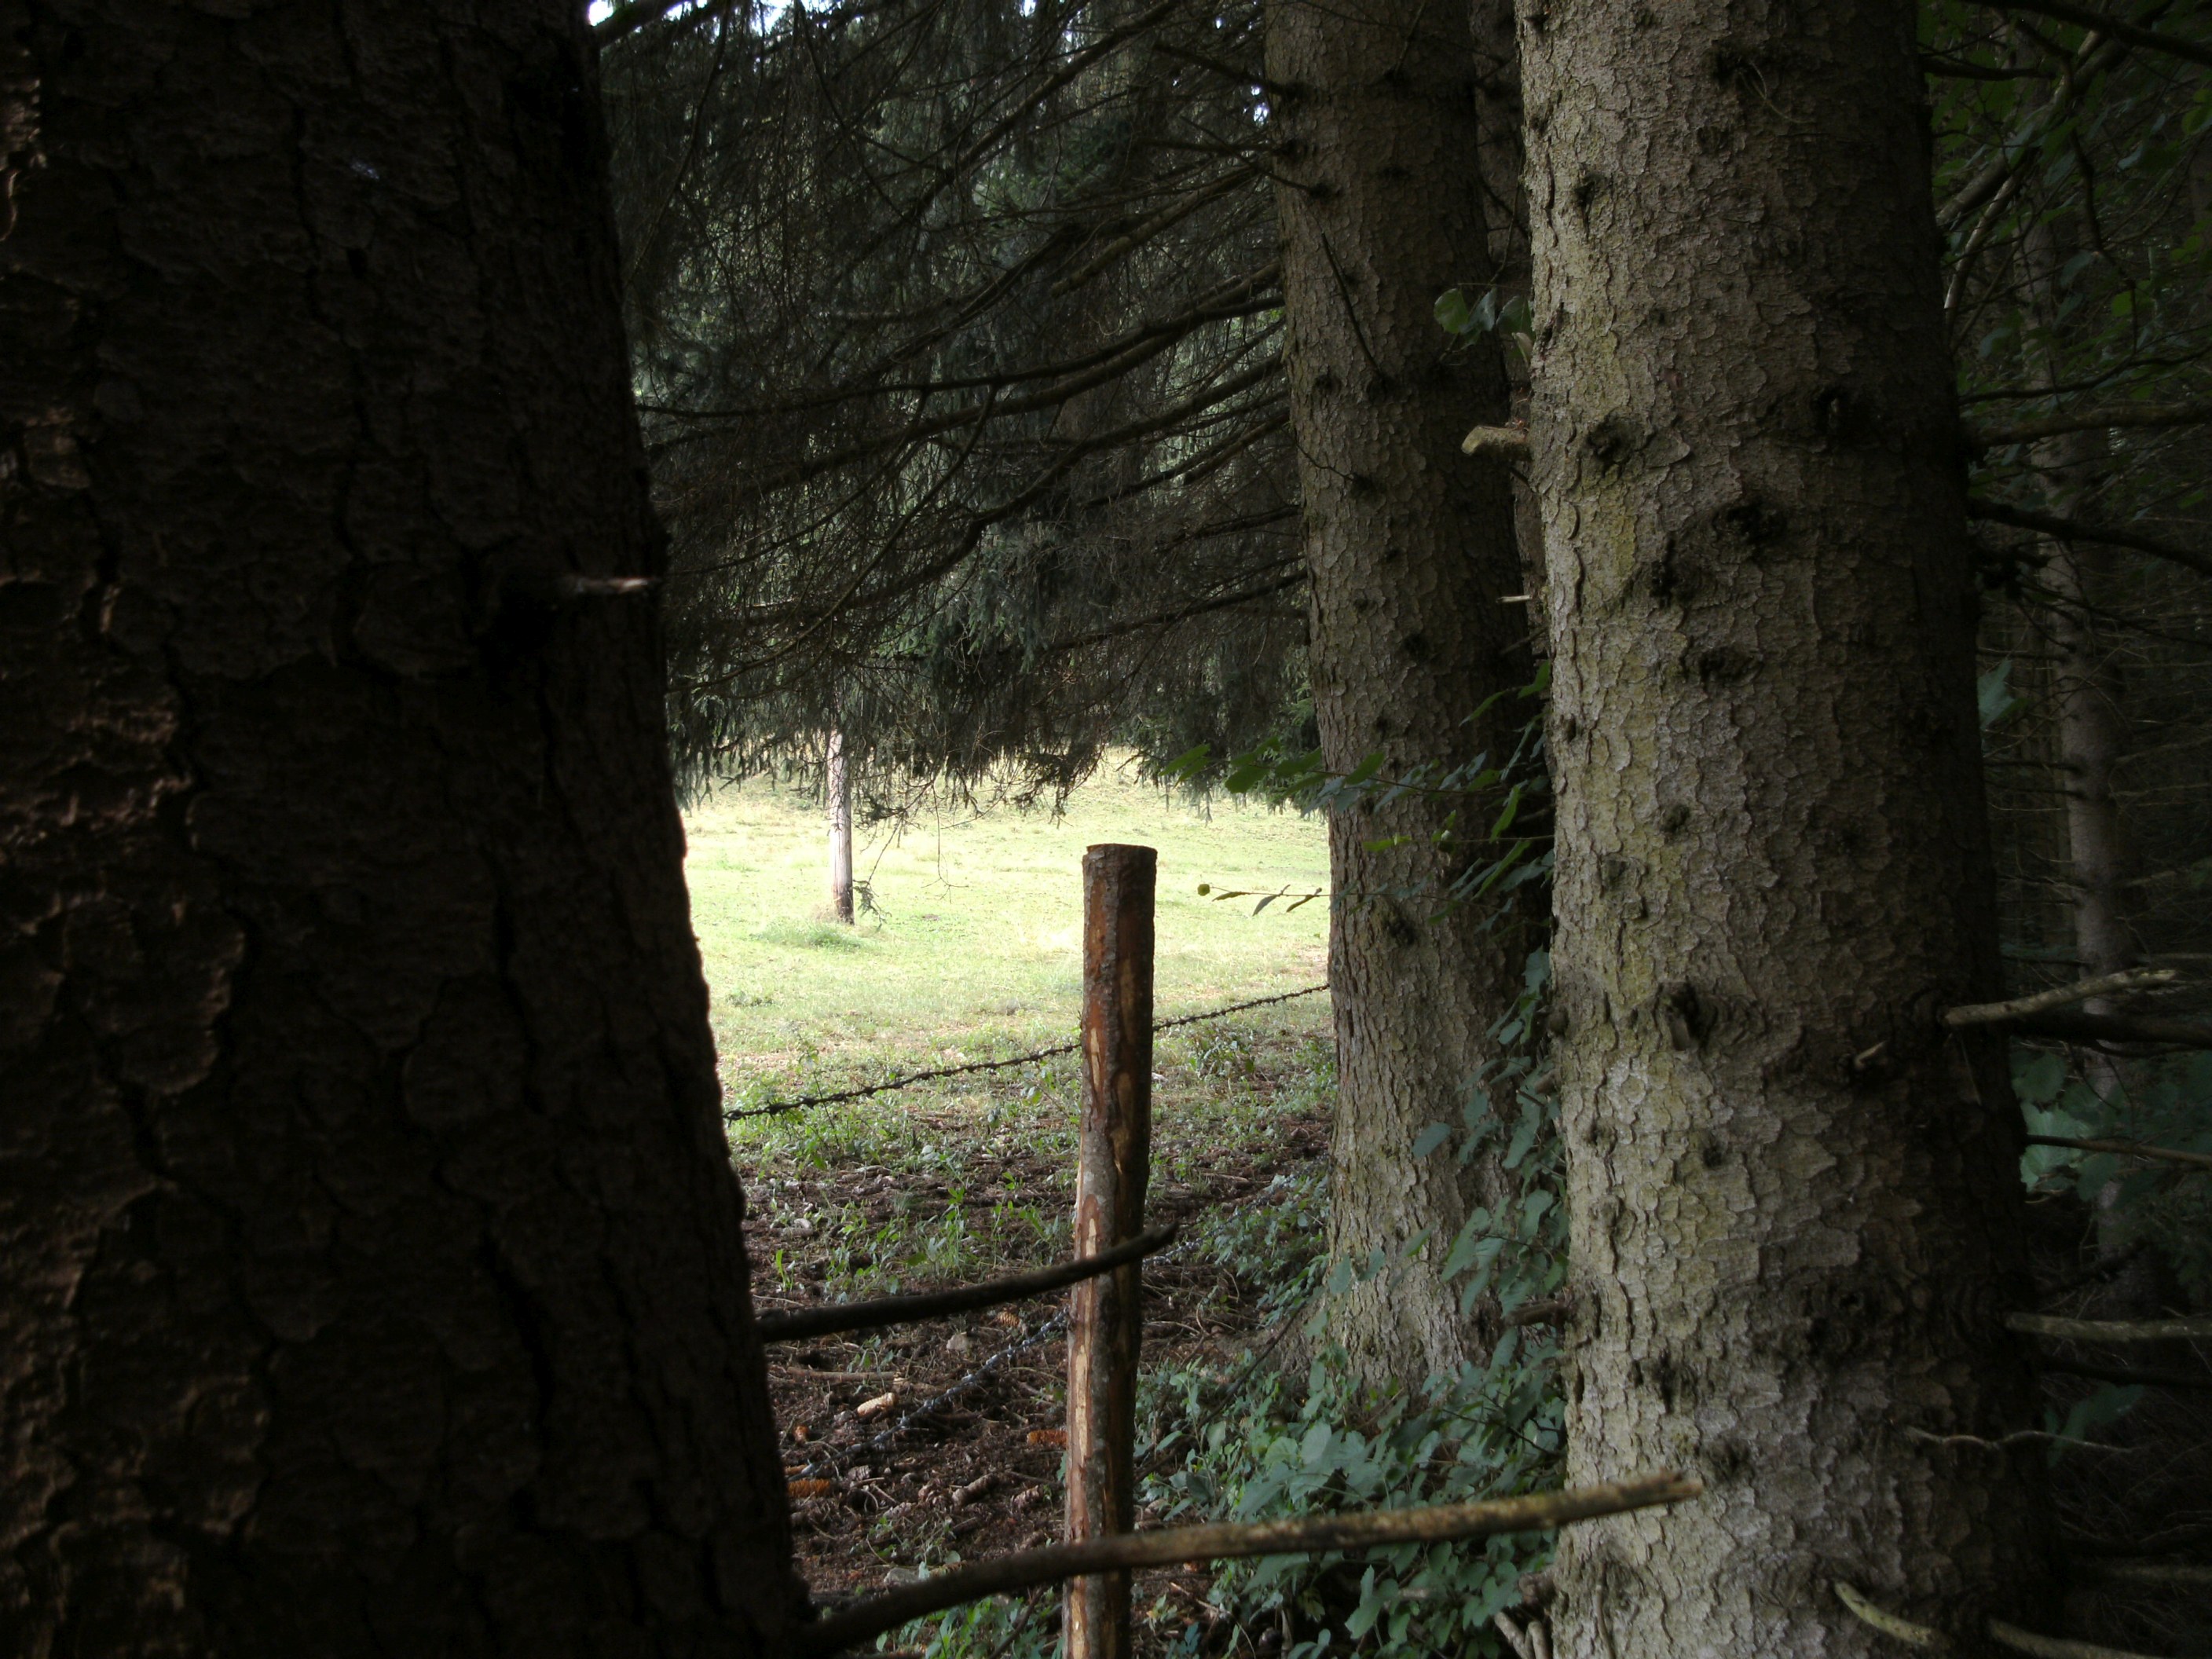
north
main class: Grassland
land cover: Grassland without tree/shrub cover
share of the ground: > 75 %
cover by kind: herbaceous plants 100 %
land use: Agriculture (excluding fallow land and kitchen gardens)
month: July
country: AT
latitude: 46.5857
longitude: 14.8136
